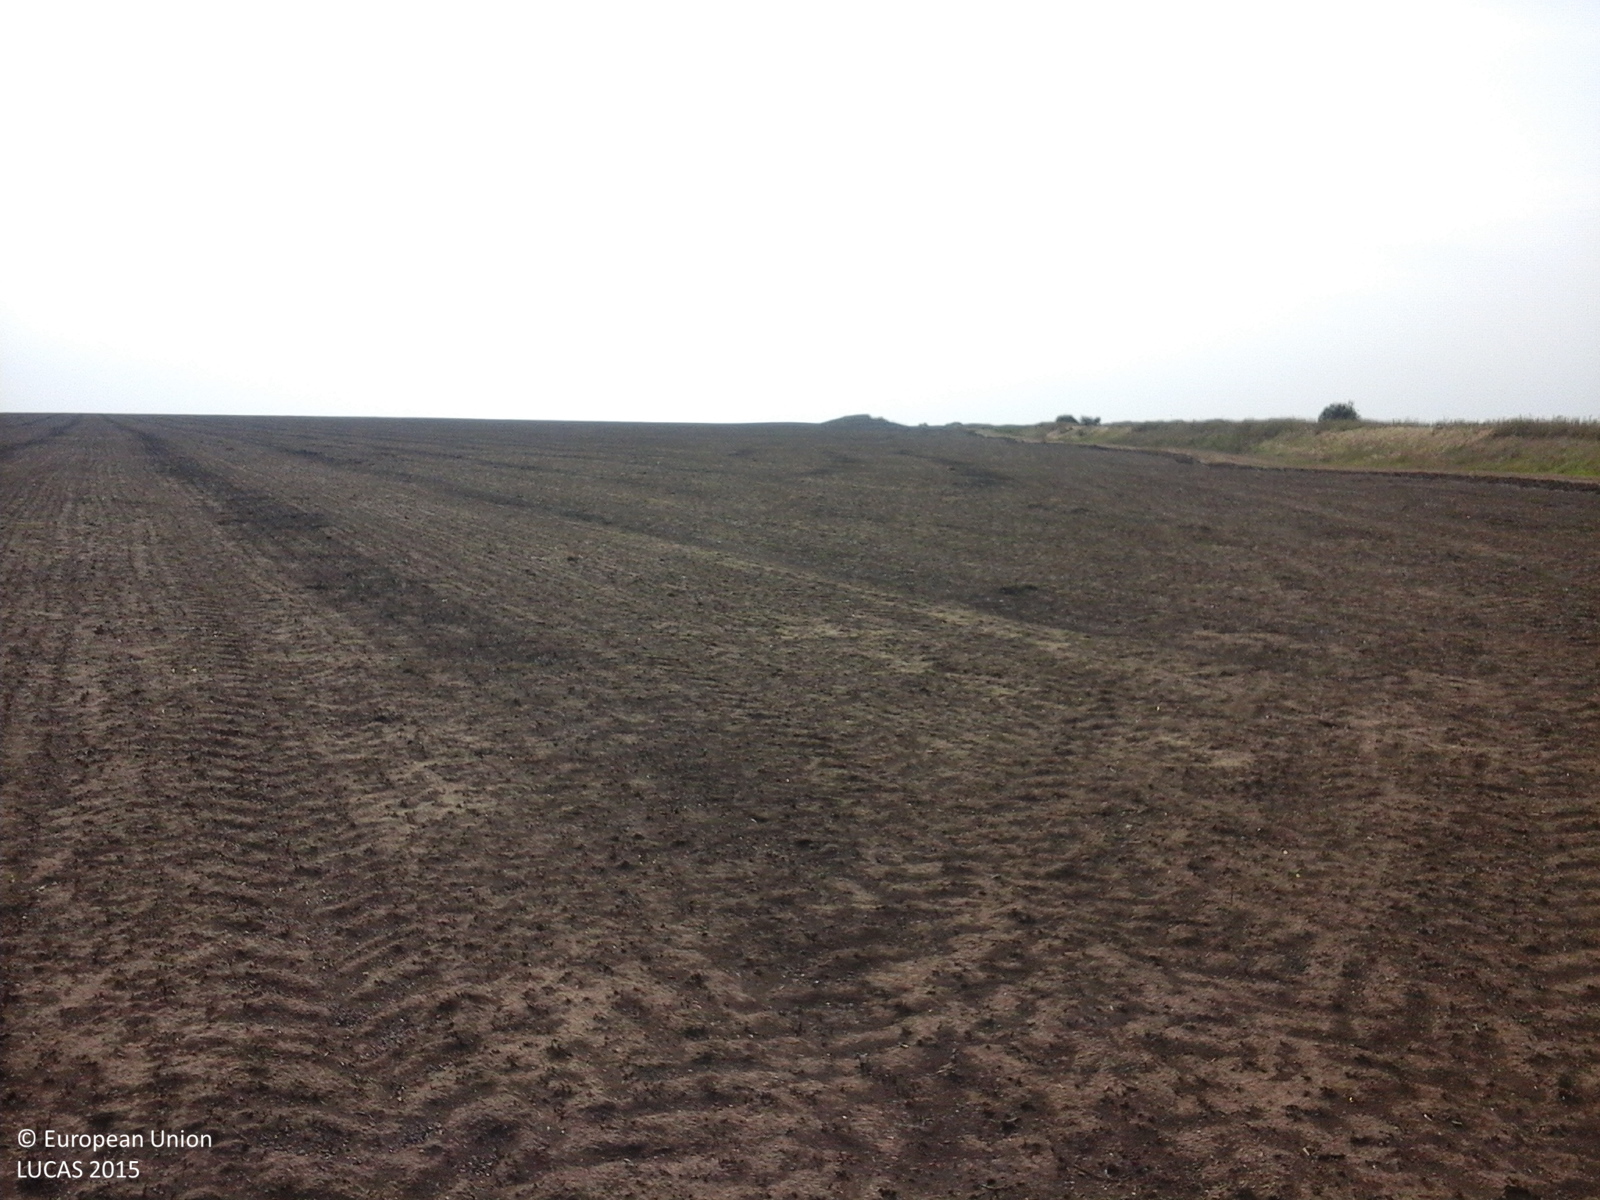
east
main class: Cropland
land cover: Common wheat
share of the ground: < 10 %
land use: Agriculture (excluding fallow land and kitchen gardens)
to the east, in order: Common wheat
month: August
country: RO
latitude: 43.8488
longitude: 28.4112
